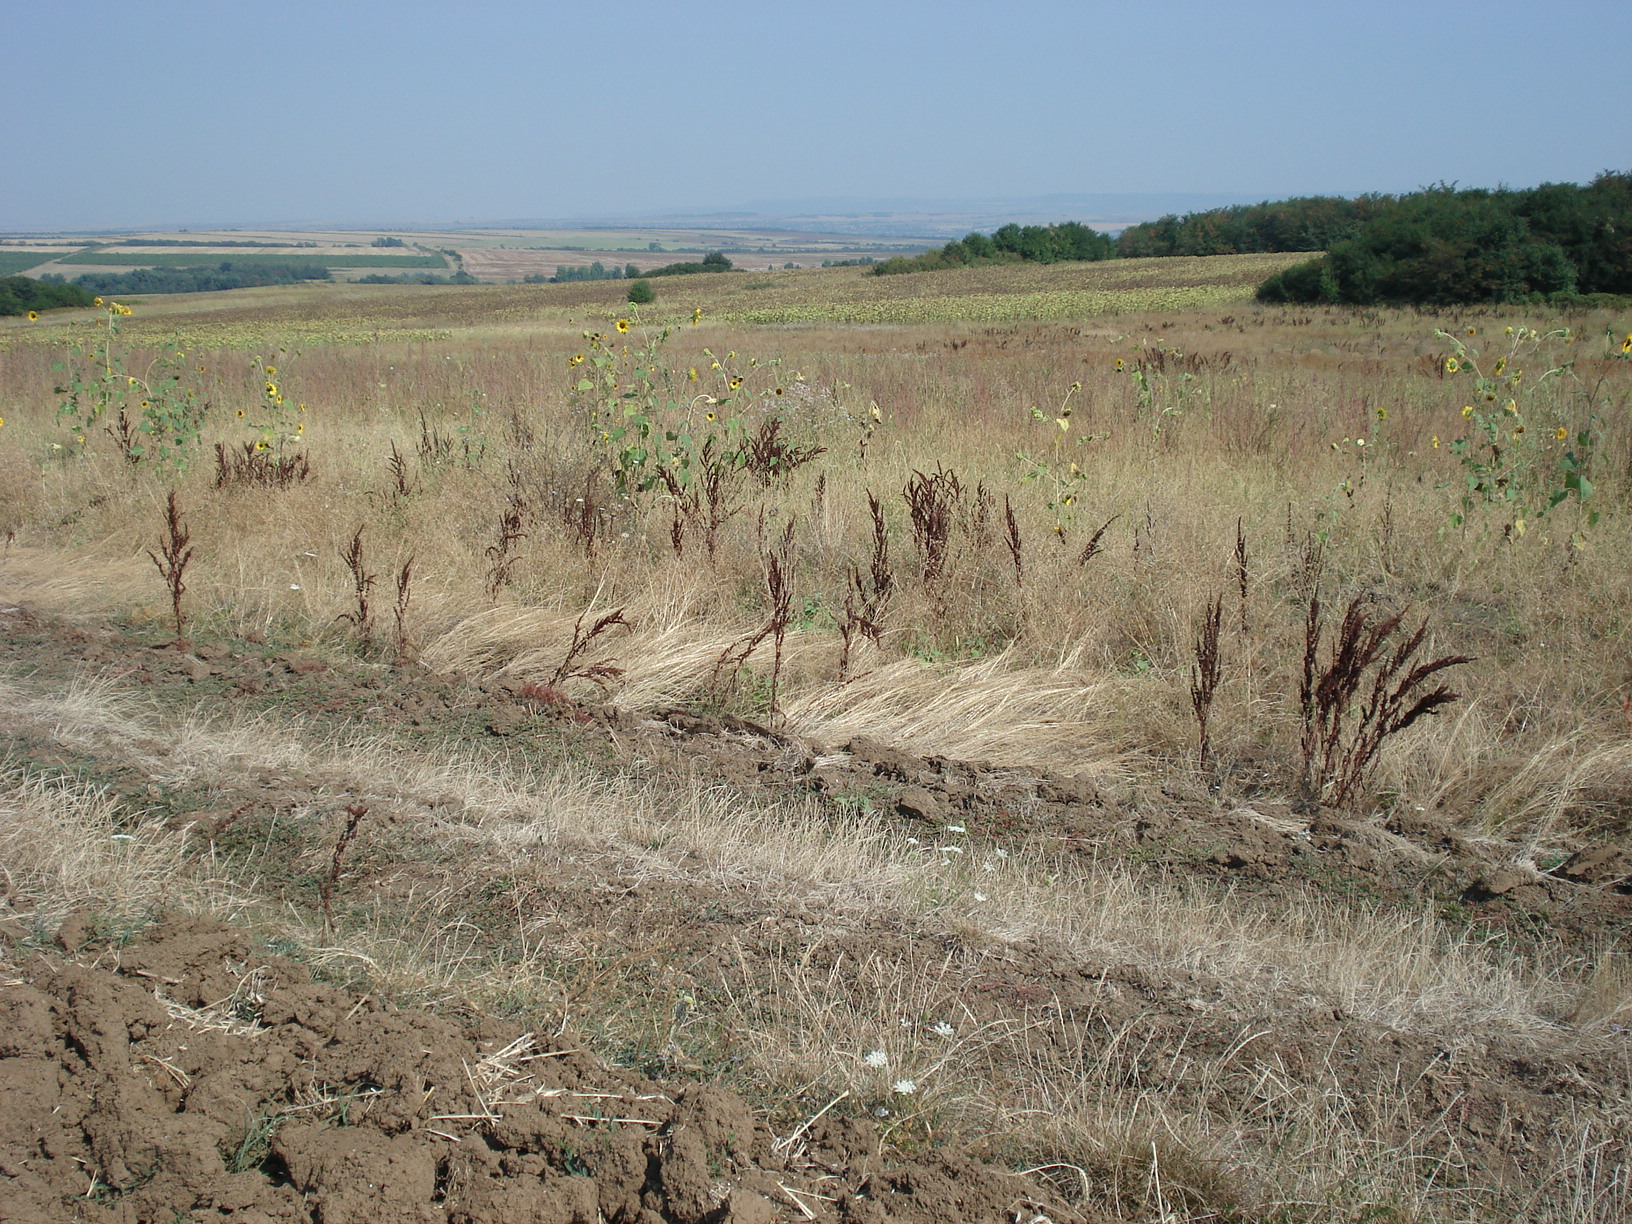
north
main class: Cropland
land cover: Common wheat
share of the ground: 50 - 75 %
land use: Agriculture (excluding fallow land and kitchen gardens)
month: August
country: BG
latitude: 43.0808
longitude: 25.7679
